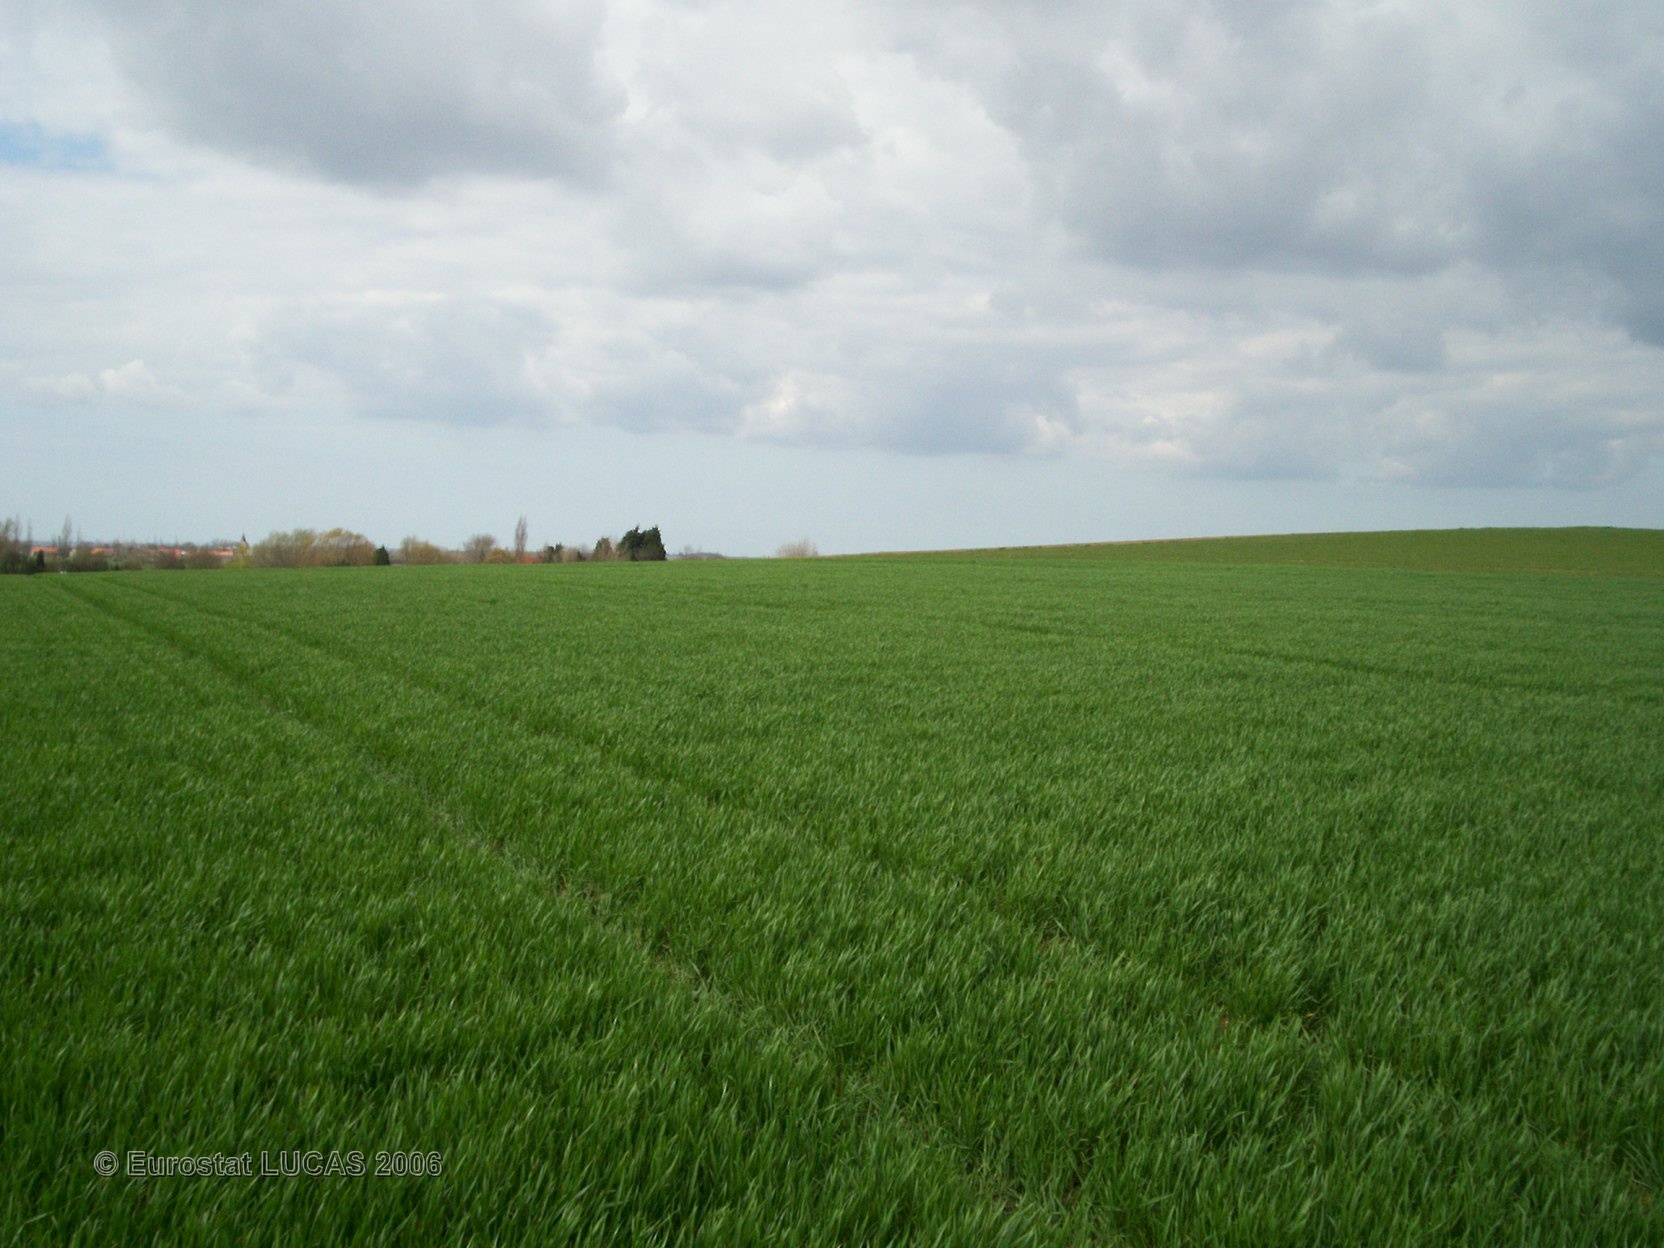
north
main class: Cropland
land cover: Common wheat
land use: Agriculture (excluding fallow land and kitchen gardens)
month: April
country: FR
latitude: 50.8846
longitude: 2.3532
